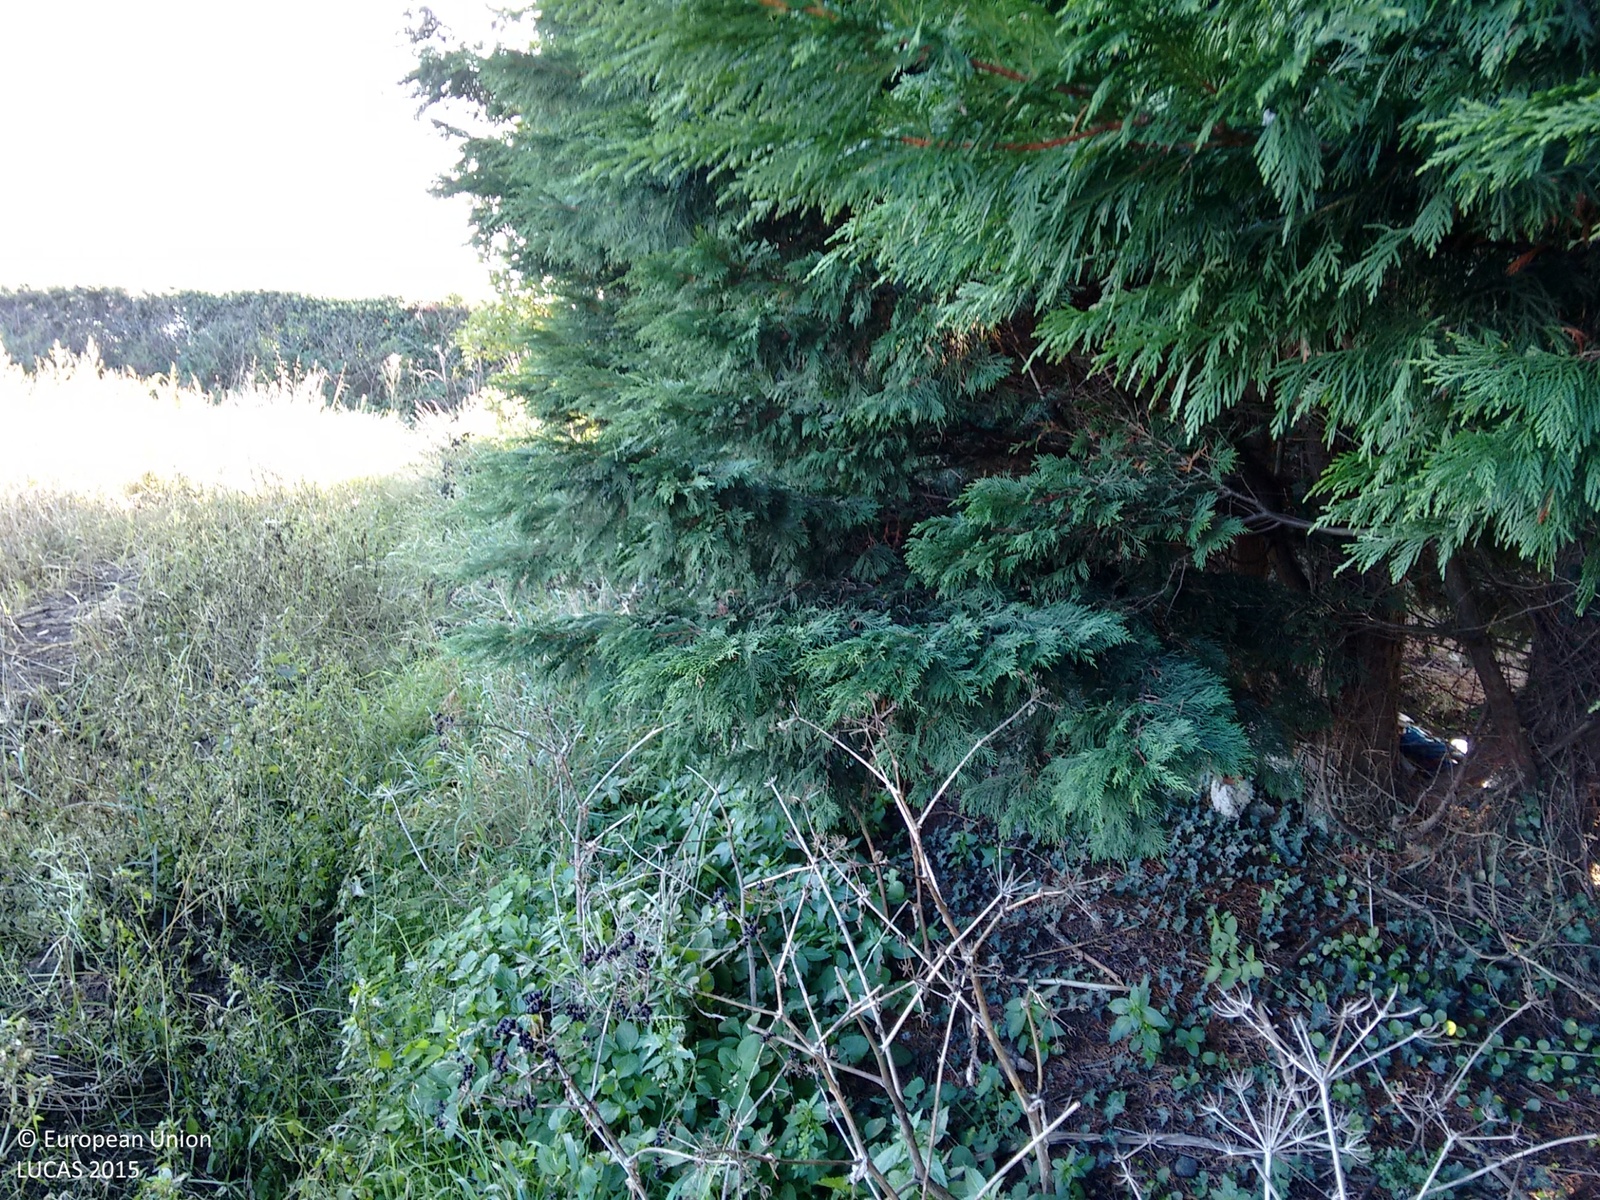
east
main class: Cropland
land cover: Common wheat
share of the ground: > 75 %
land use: Agriculture (excluding fallow land and kitchen gardens)
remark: Harvested field
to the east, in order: Managed hedges; Artificial constructions in urban areas; Grass margins; Other bare soil; Grassland without tree/shrub cover; Artificial constructions in urban areas; Other bare soil
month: October
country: GB
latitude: 52.6997
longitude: 1.6807
